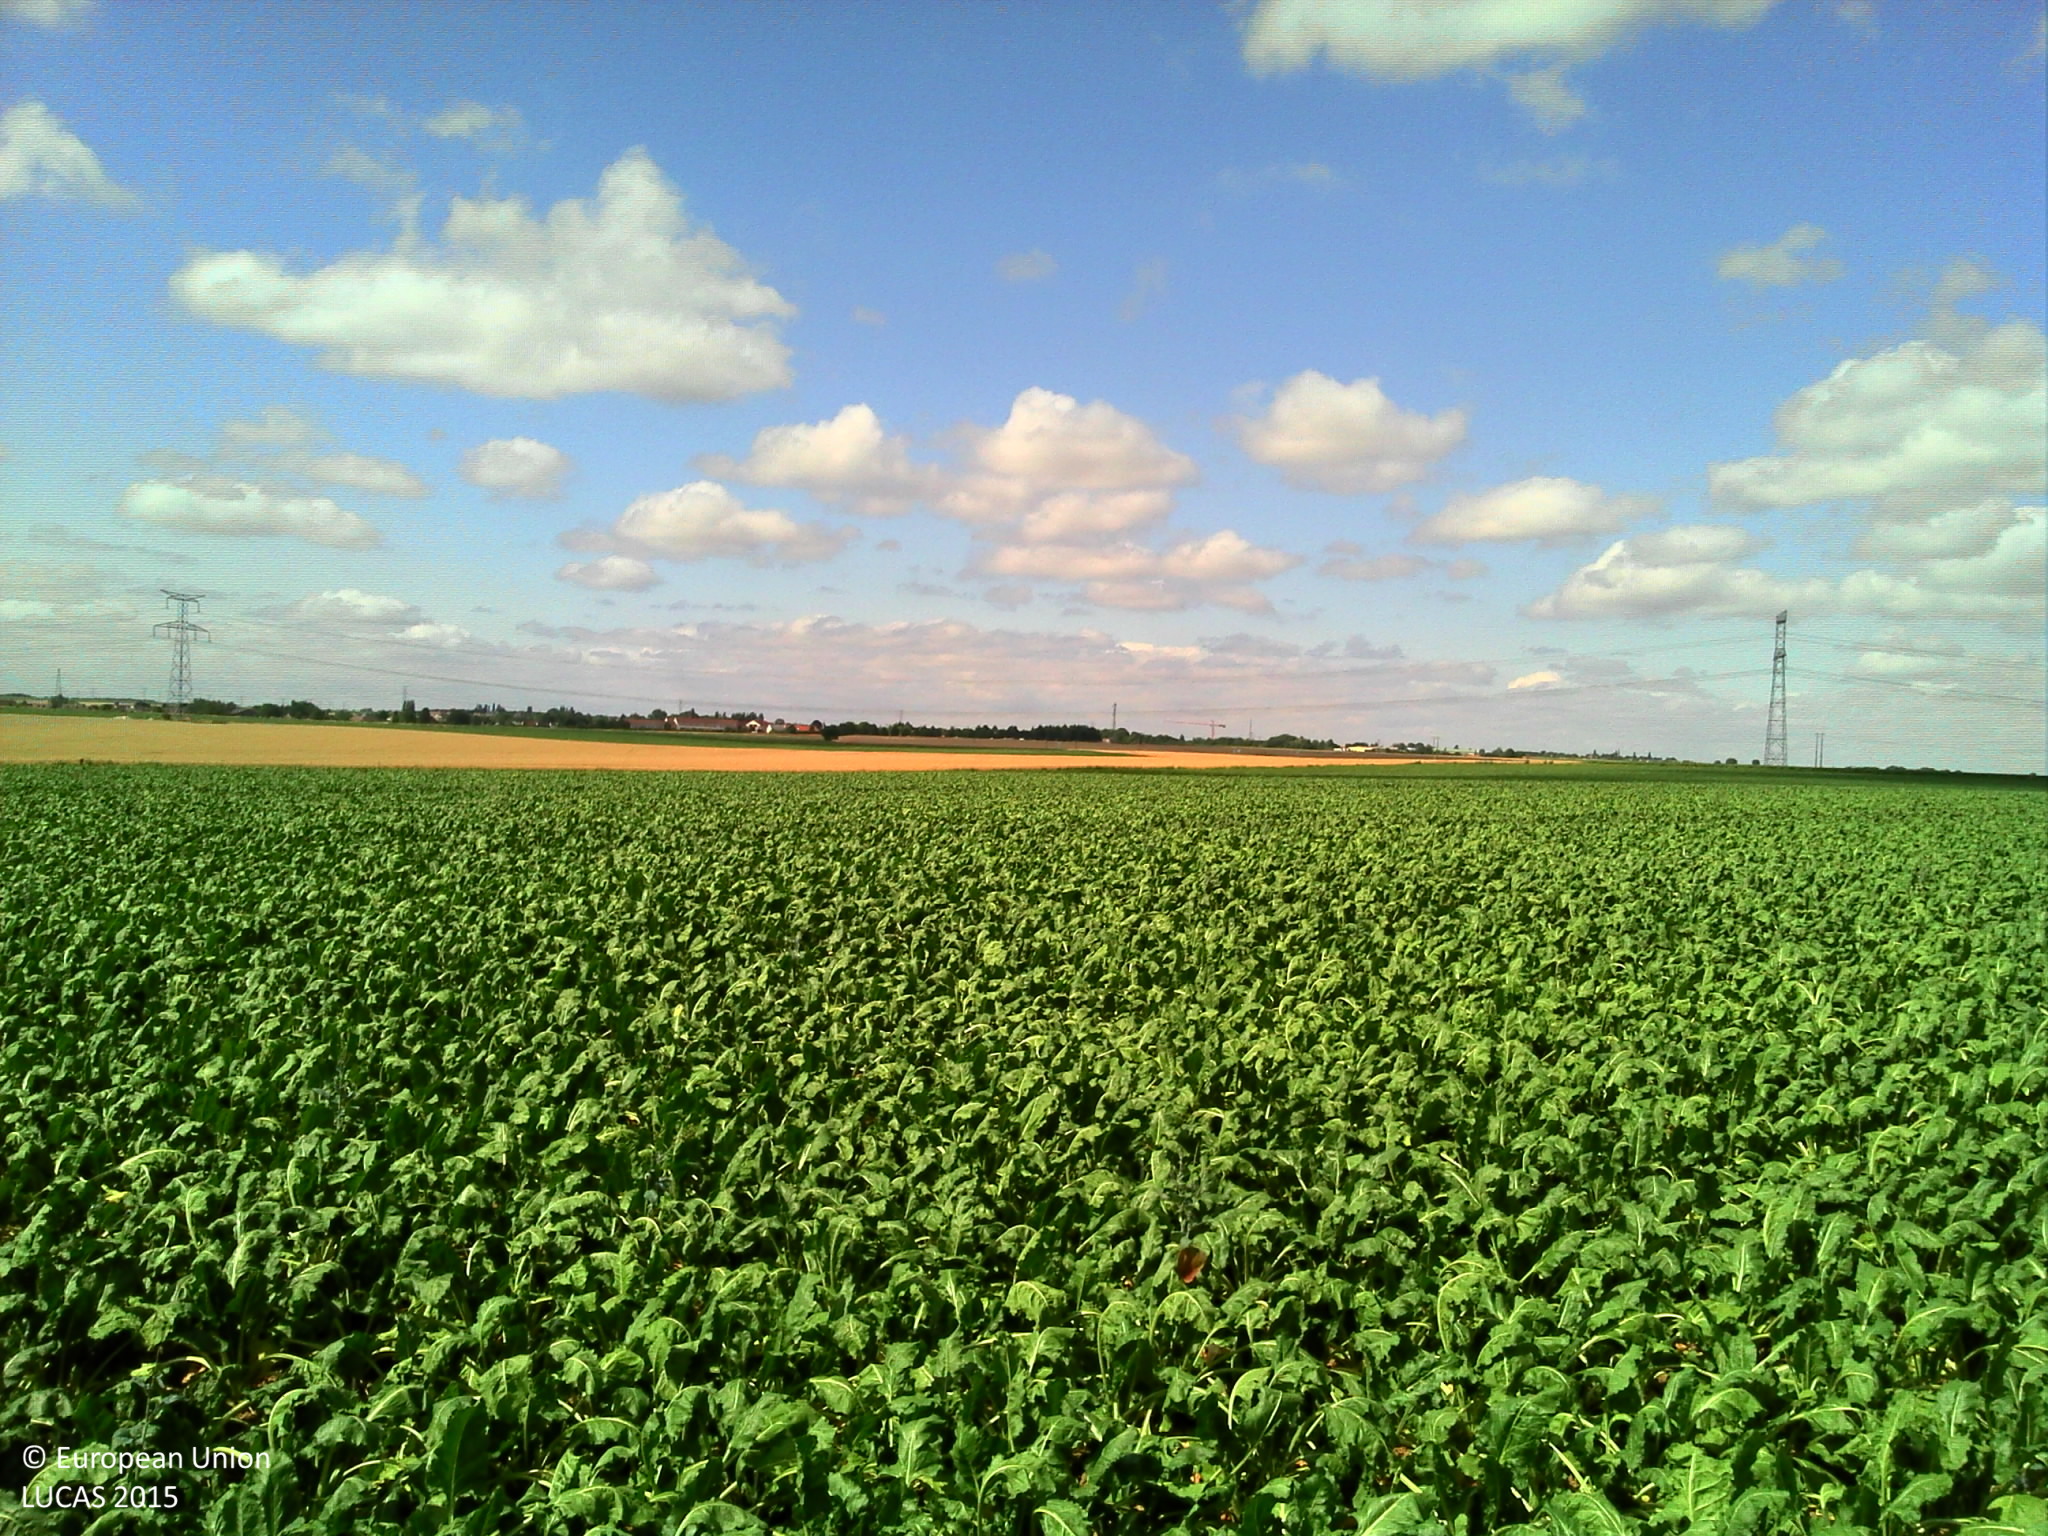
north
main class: Cropland
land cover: Sugar beet
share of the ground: > 75 %
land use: Agriculture (excluding fallow land and kitchen gardens)
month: July
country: FR
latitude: 49.2001
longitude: 2.2879
